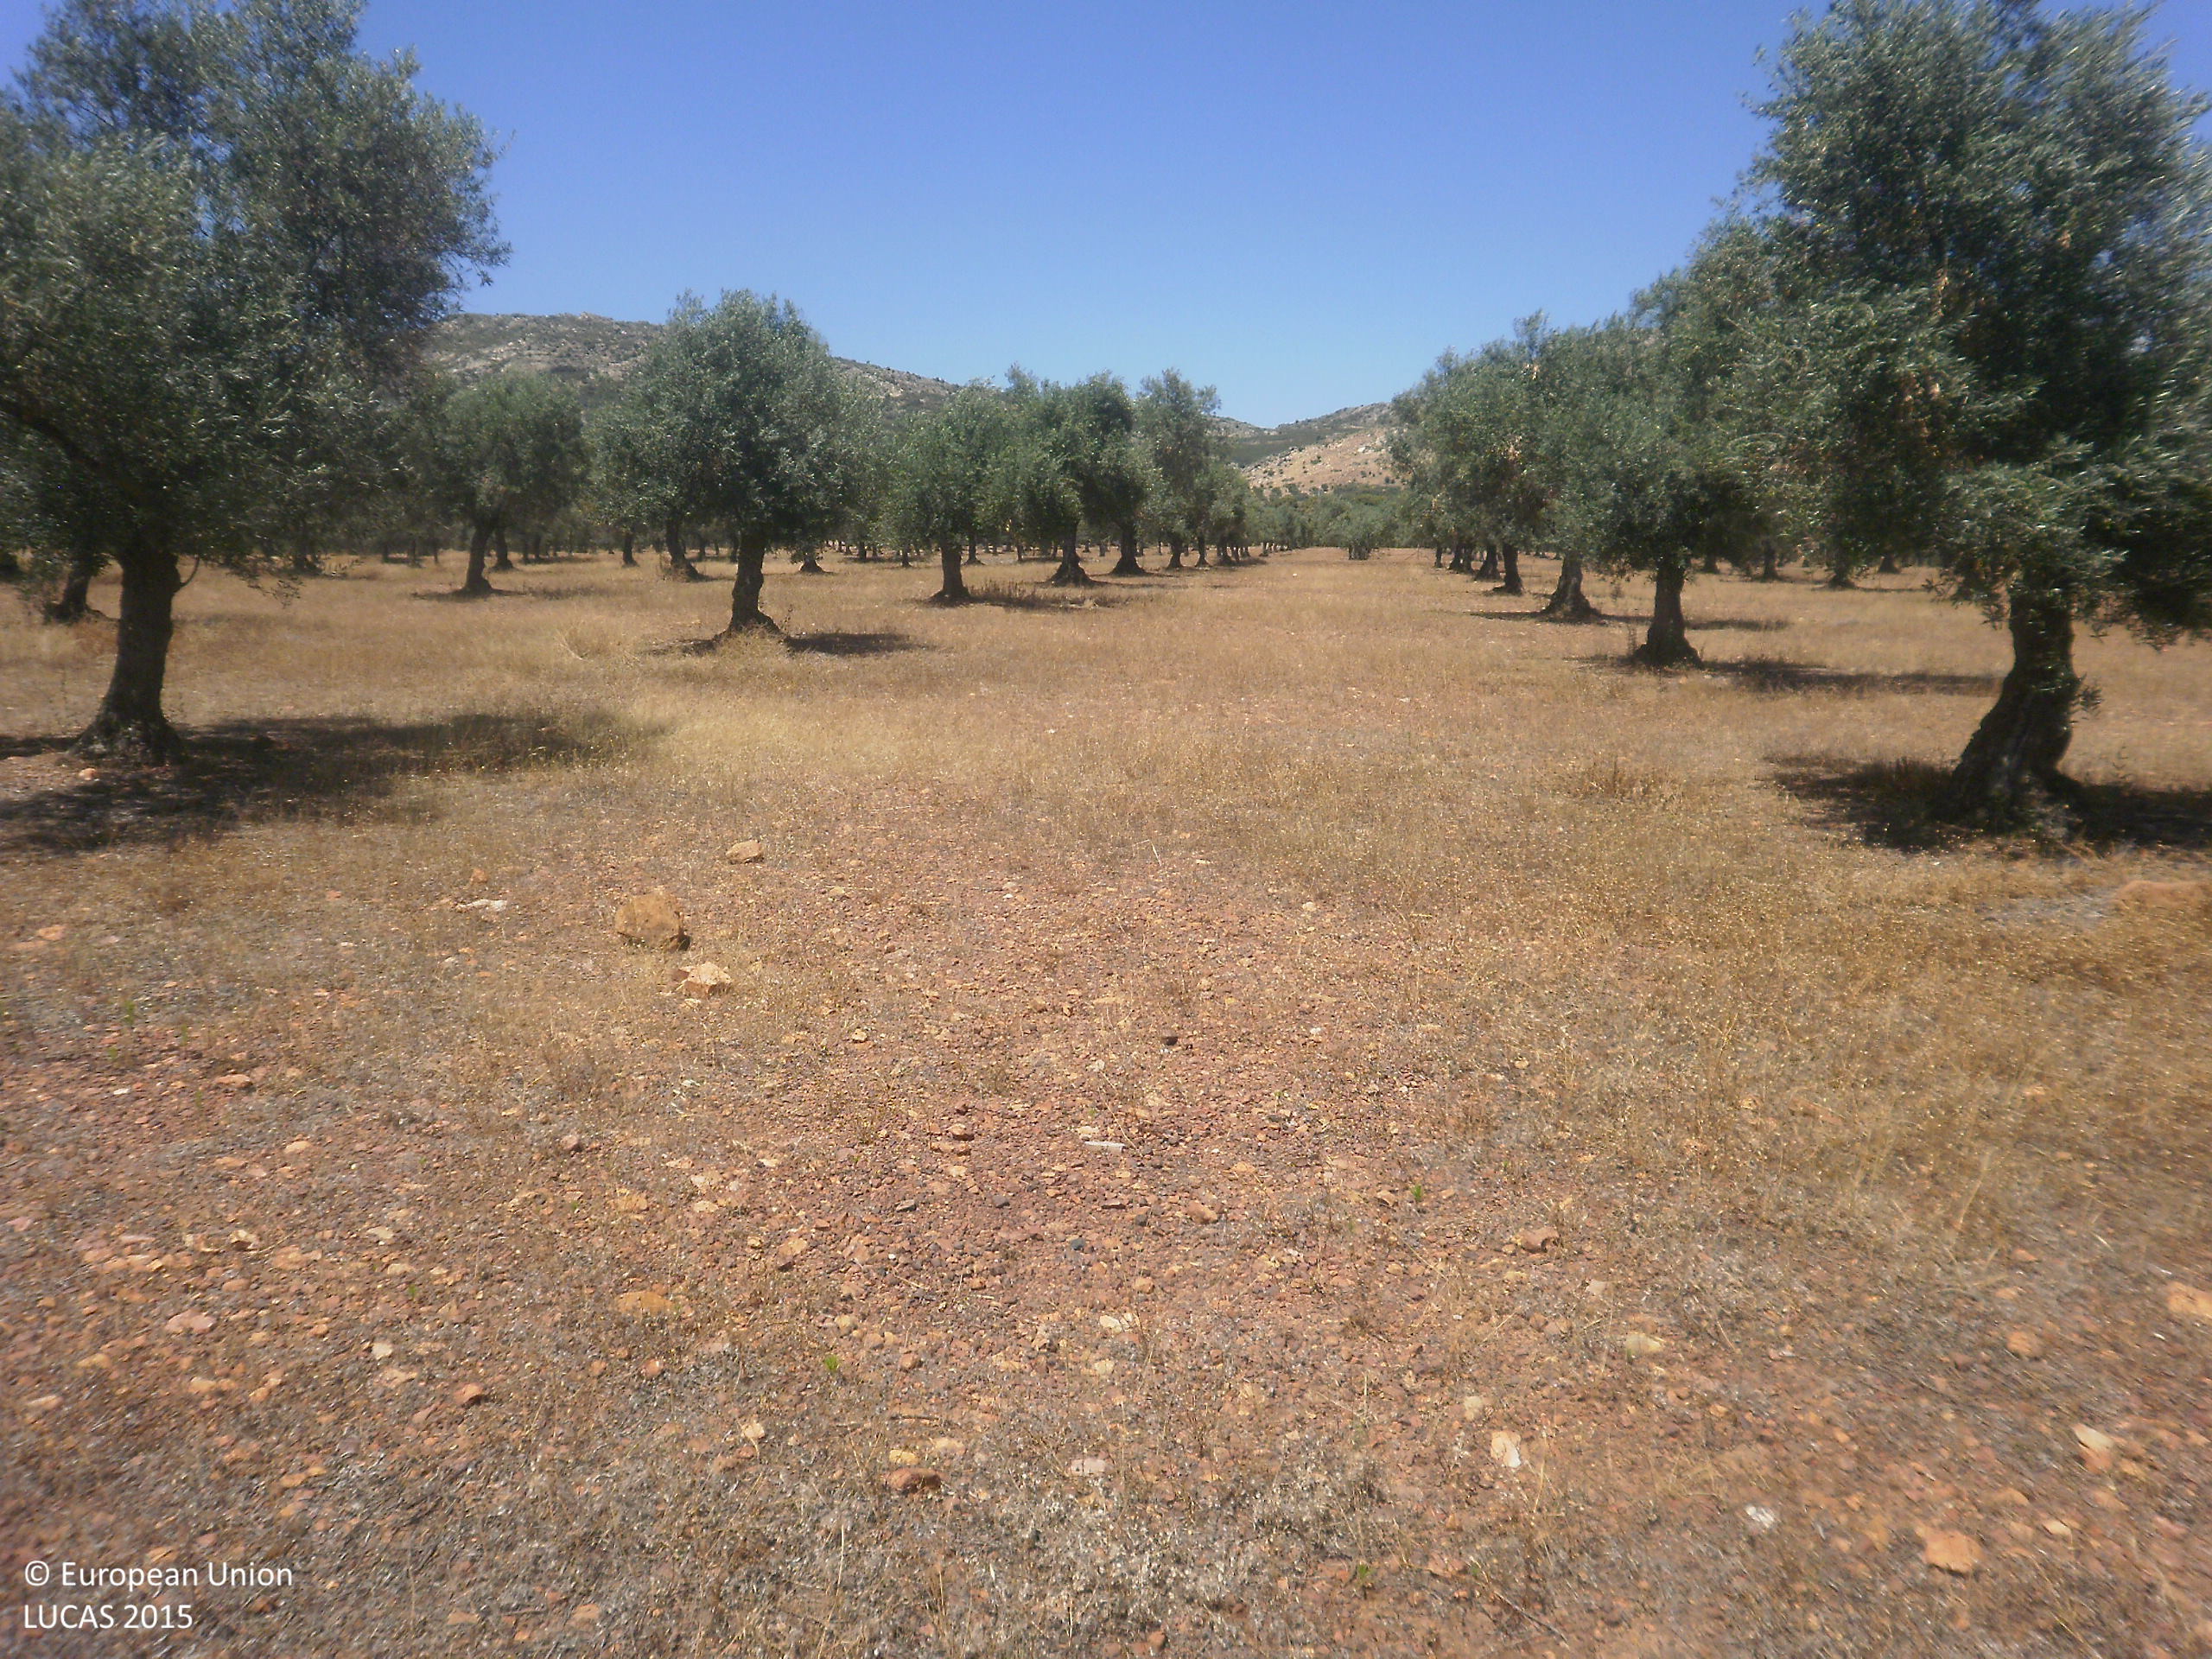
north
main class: Cropland
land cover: Olive groves
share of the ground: 25 - 50 %
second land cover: Grassland without tree/shrub cover
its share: 25 - 50 %
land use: Agriculture (excluding fallow land and kitchen gardens)
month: June
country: ES
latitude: 38.6711
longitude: -5.4271
